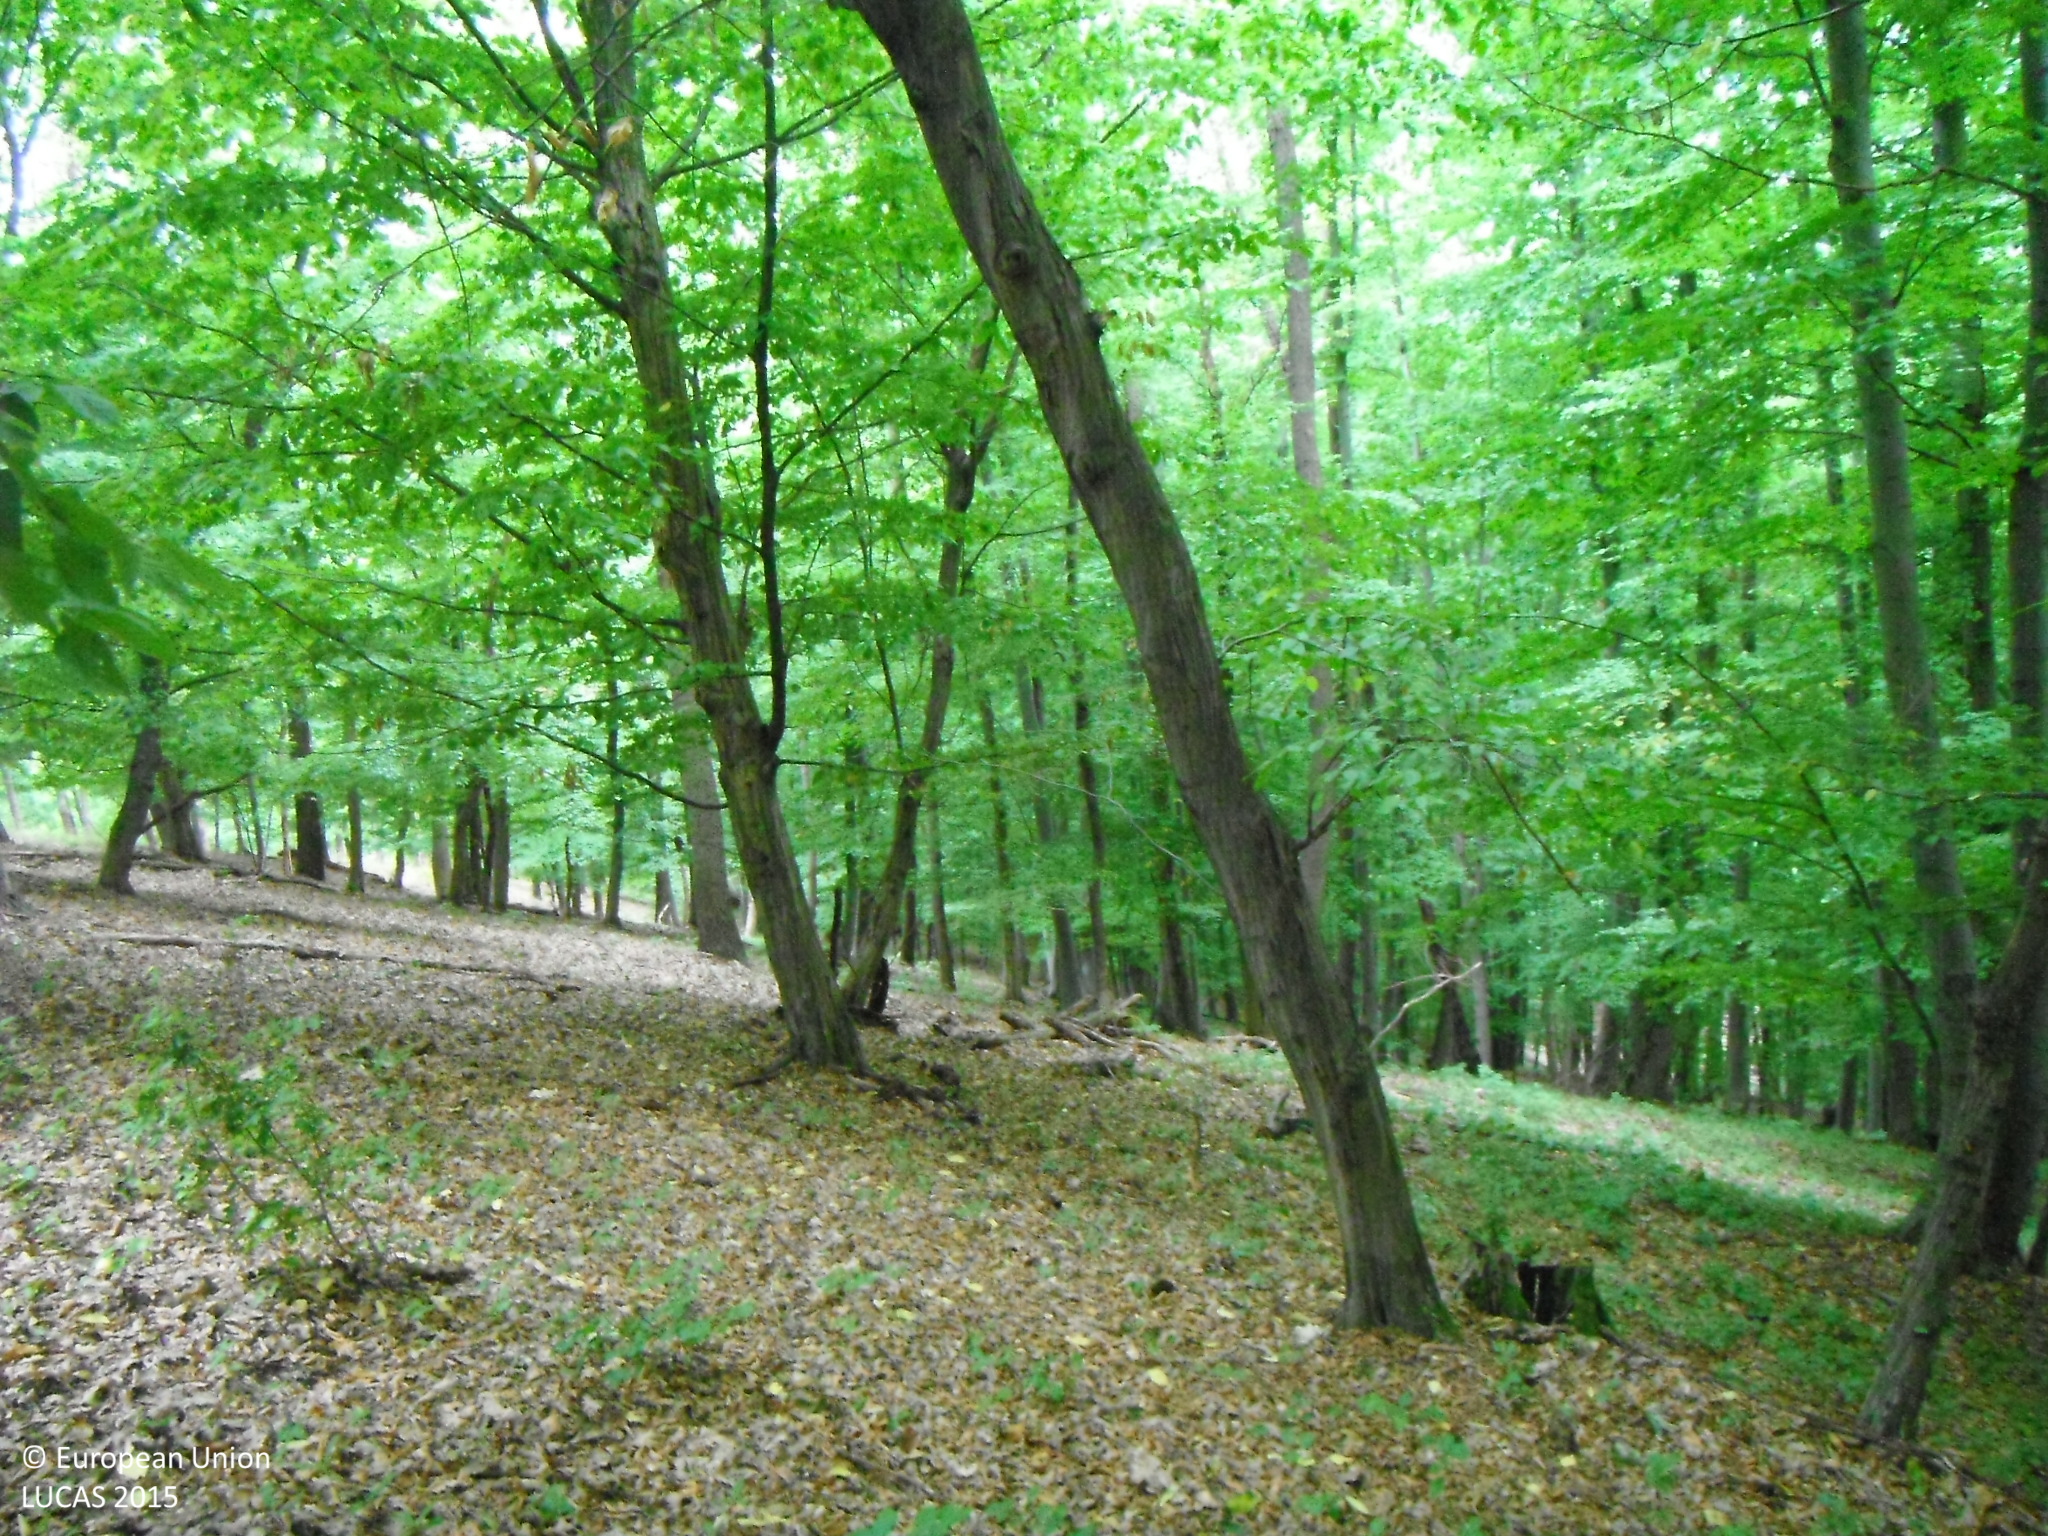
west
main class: Woodland
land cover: Broadleaved woodland
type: mesophytic deciduous forest
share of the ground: > 75 %
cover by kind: broadleaved forest trees 100 %
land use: Forestry
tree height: > 5 m
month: July
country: SK
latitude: 48.1972
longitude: 19.8620
